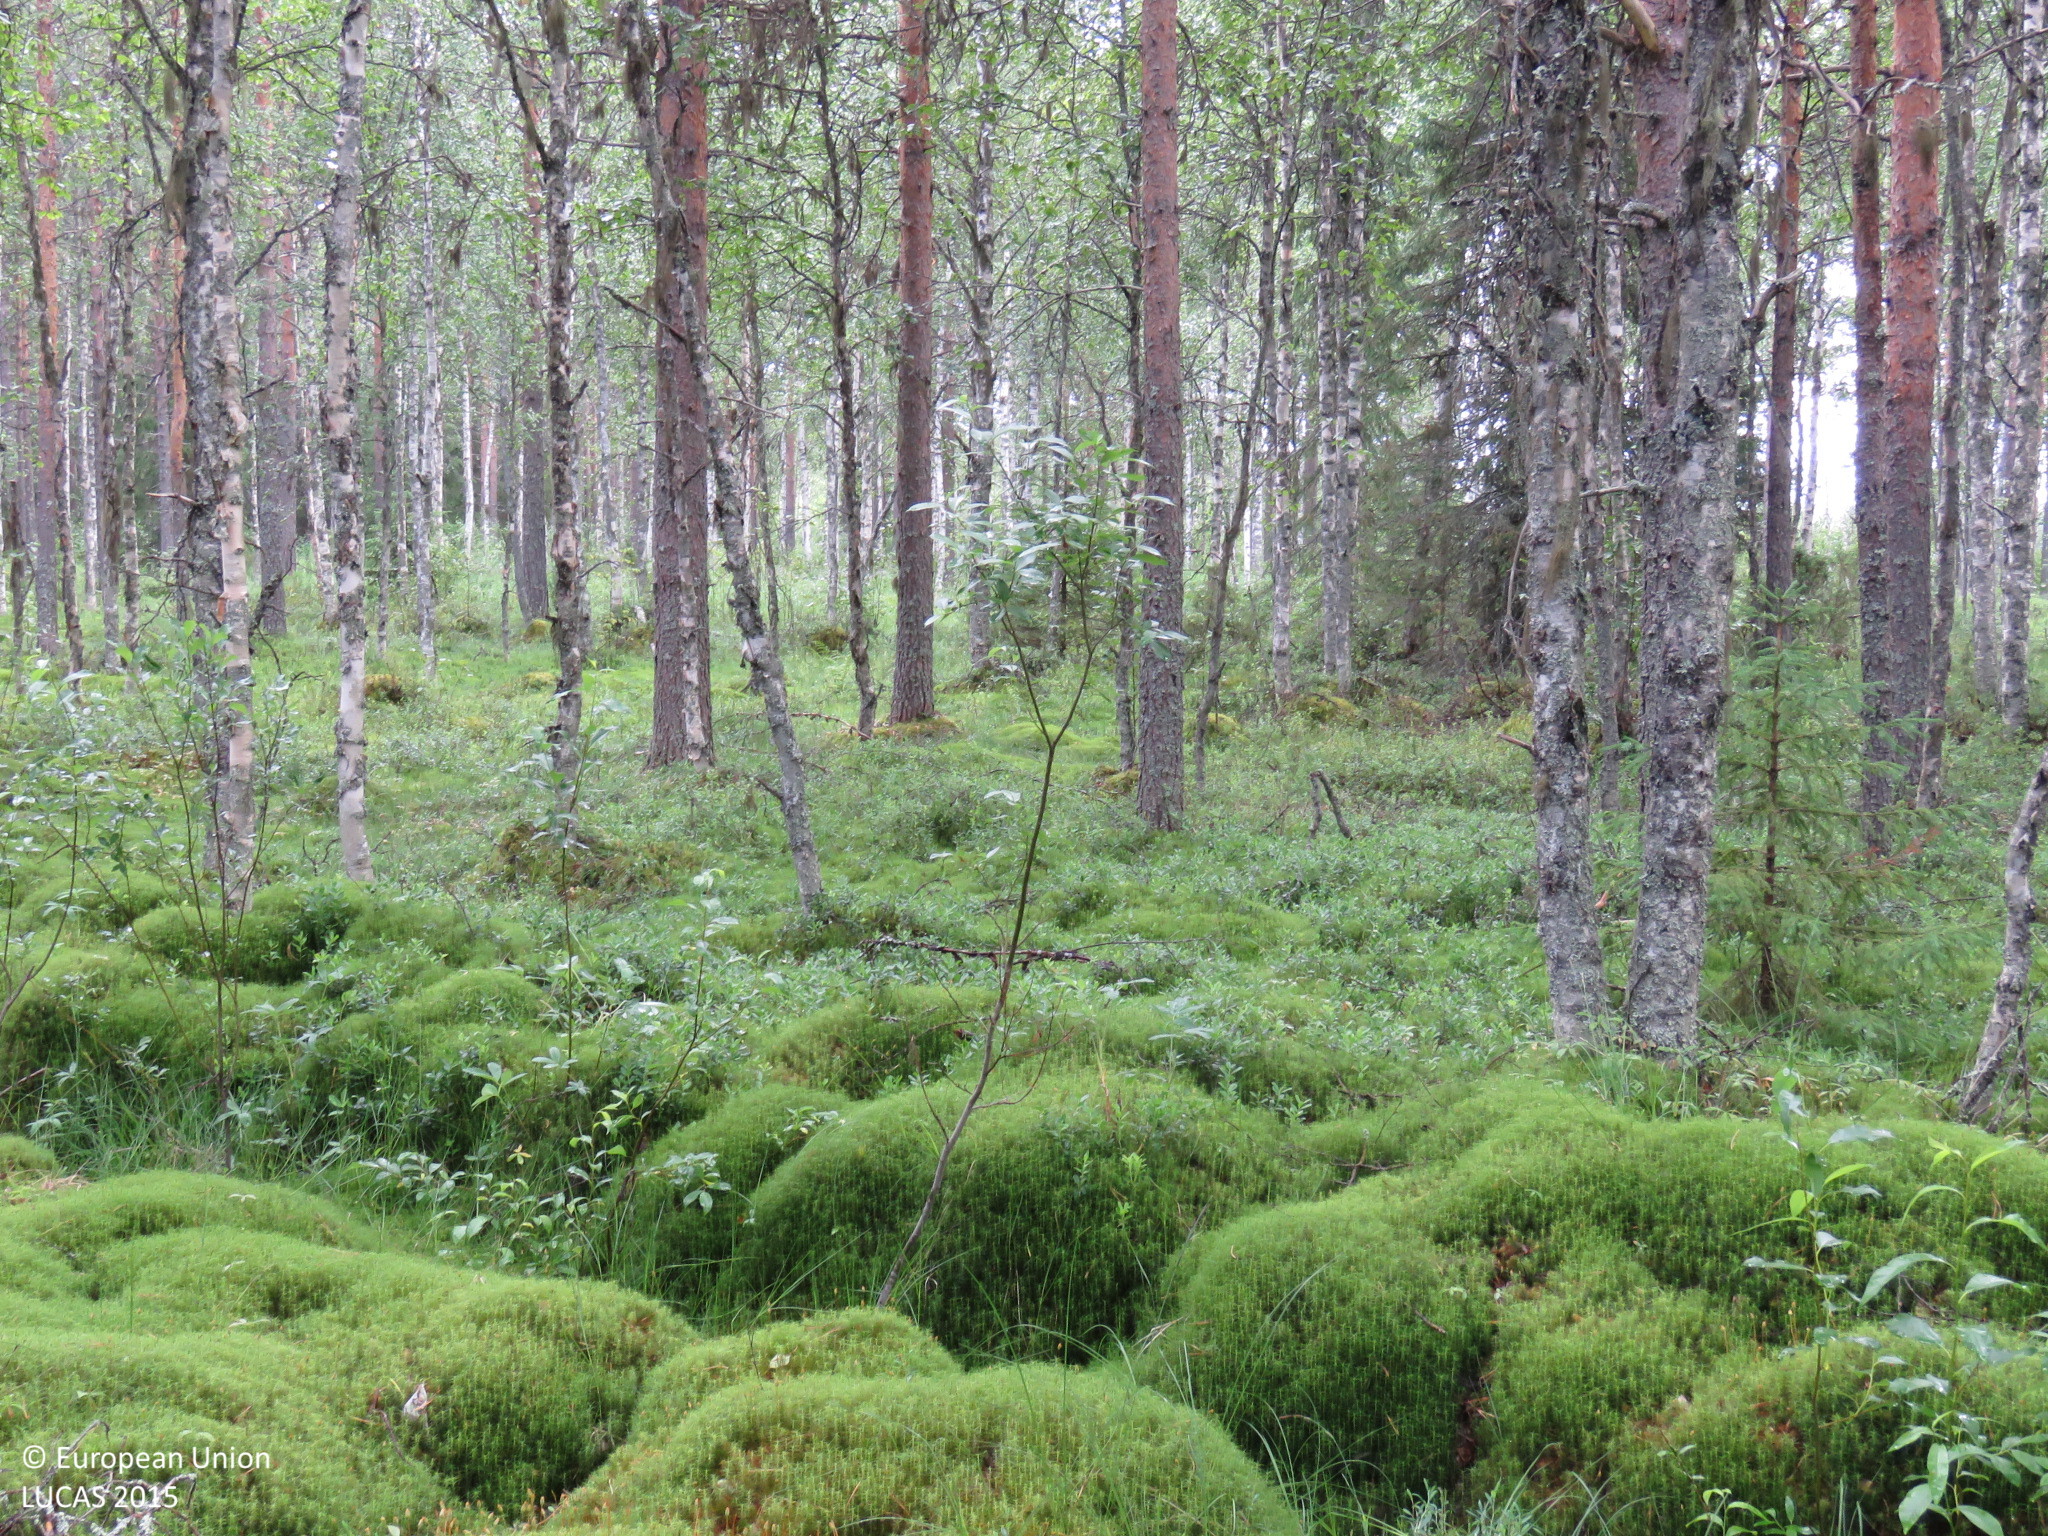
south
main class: Woodland
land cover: Broadleaved woodland
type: non-riverine alder, birch or aspen forest
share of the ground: > 75 %
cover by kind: broadleaved forest trees 65 %, coniferous forest trees 20 %, lichens and mosses 10 %, shrubs 5 %
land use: Forestry
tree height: > 5 m
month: July
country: FI
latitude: 64.4818
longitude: 26.5732
